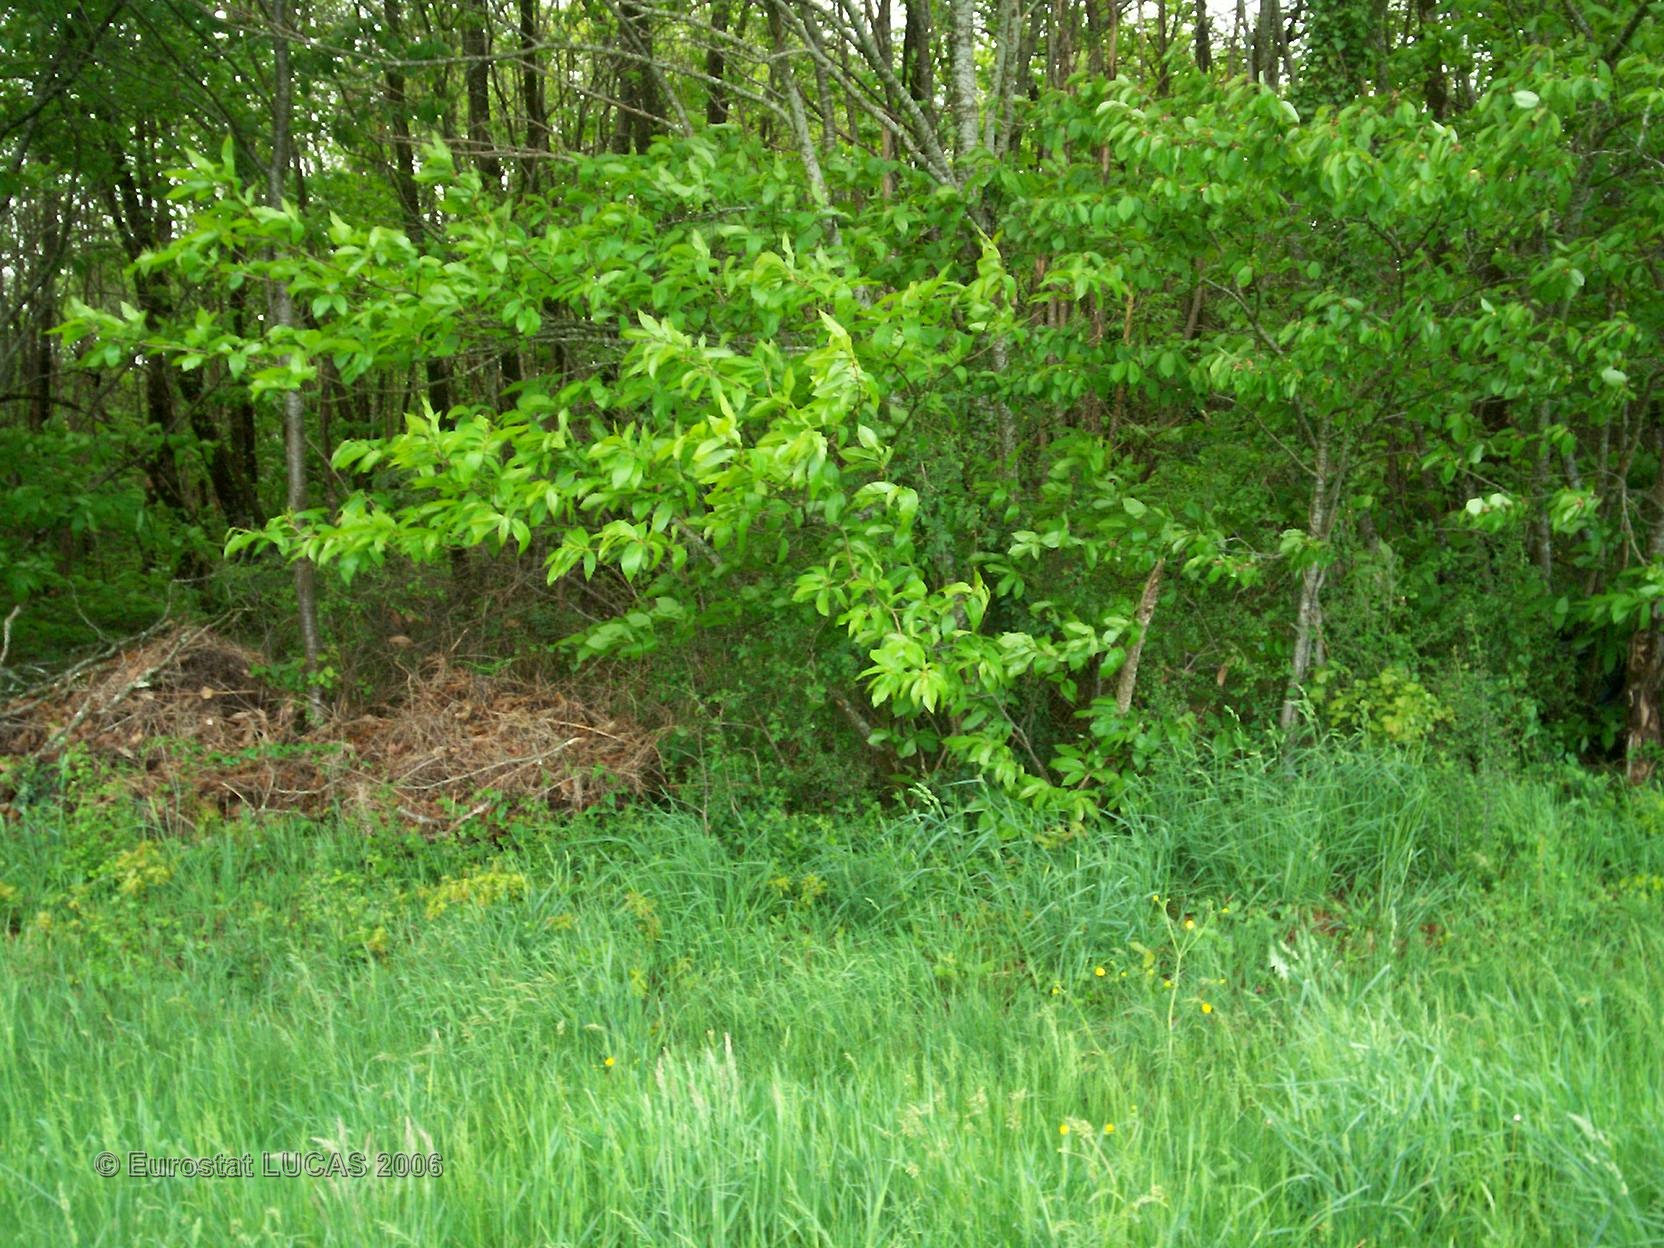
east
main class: Grassland
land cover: Grassland without tree/shrub cover
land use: Logistics and storage
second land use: Agriculture (excluding fallow land and kitchen gardens)
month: May
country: FR
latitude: 46.0306
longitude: 0.4365
